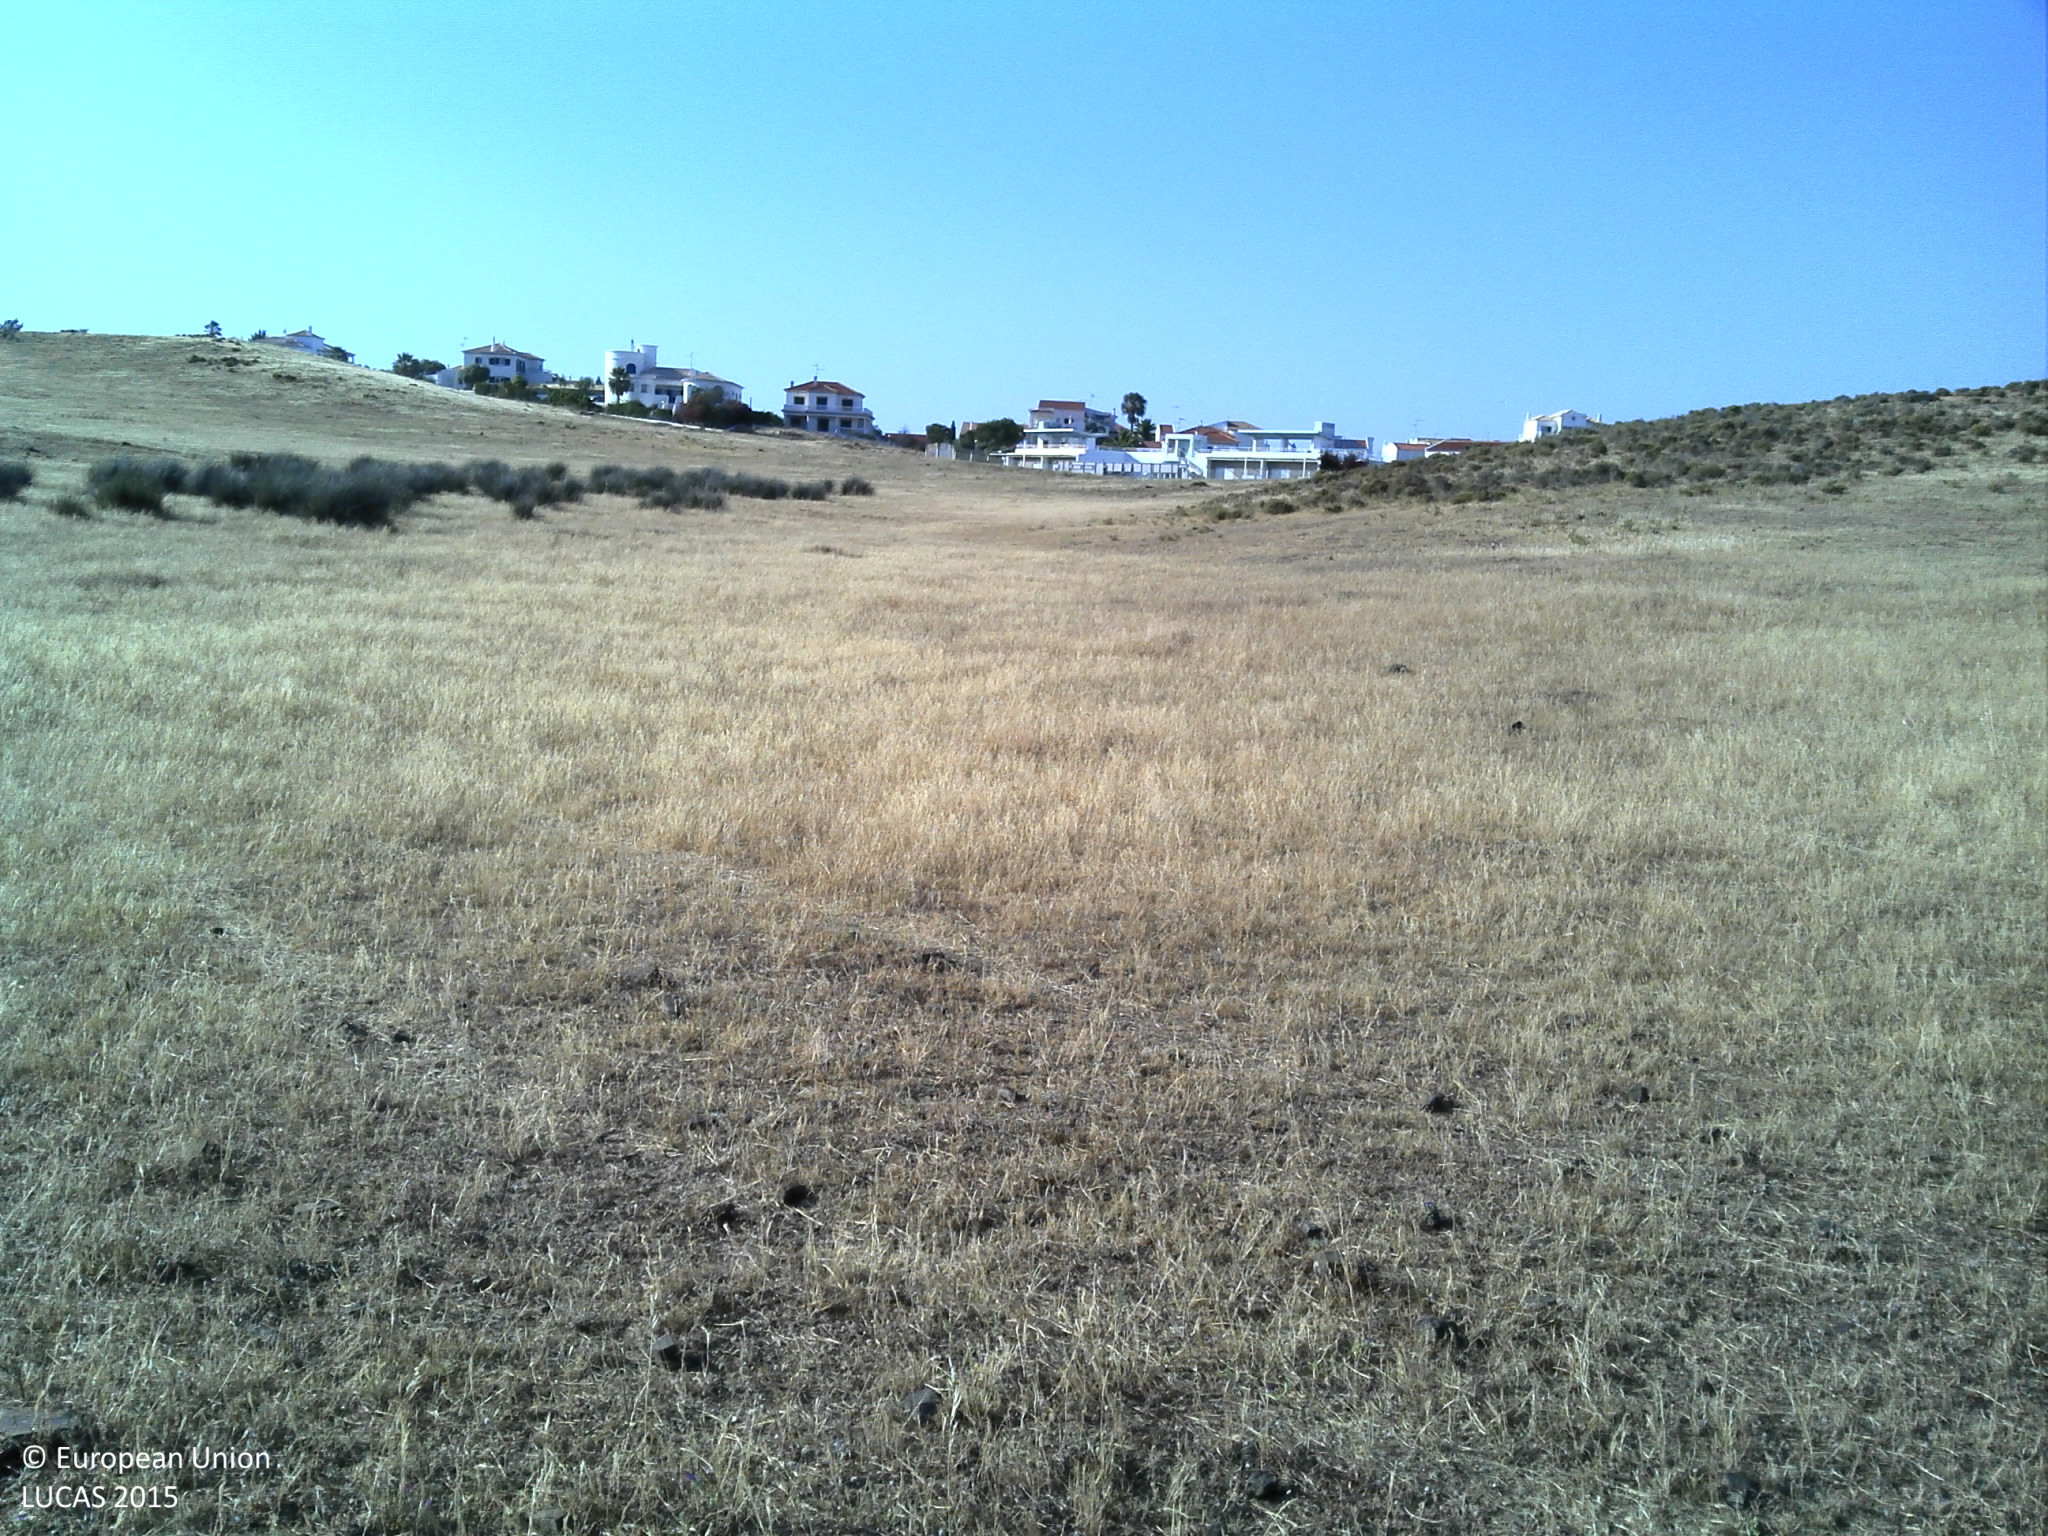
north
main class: Grassland
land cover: Grassland without tree/shrub cover
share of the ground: > 75 %
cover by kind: herbaceous plants 100 %
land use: Agriculture (excluding fallow land and kitchen gardens)
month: May
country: PT
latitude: 37.2064
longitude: -7.4787
